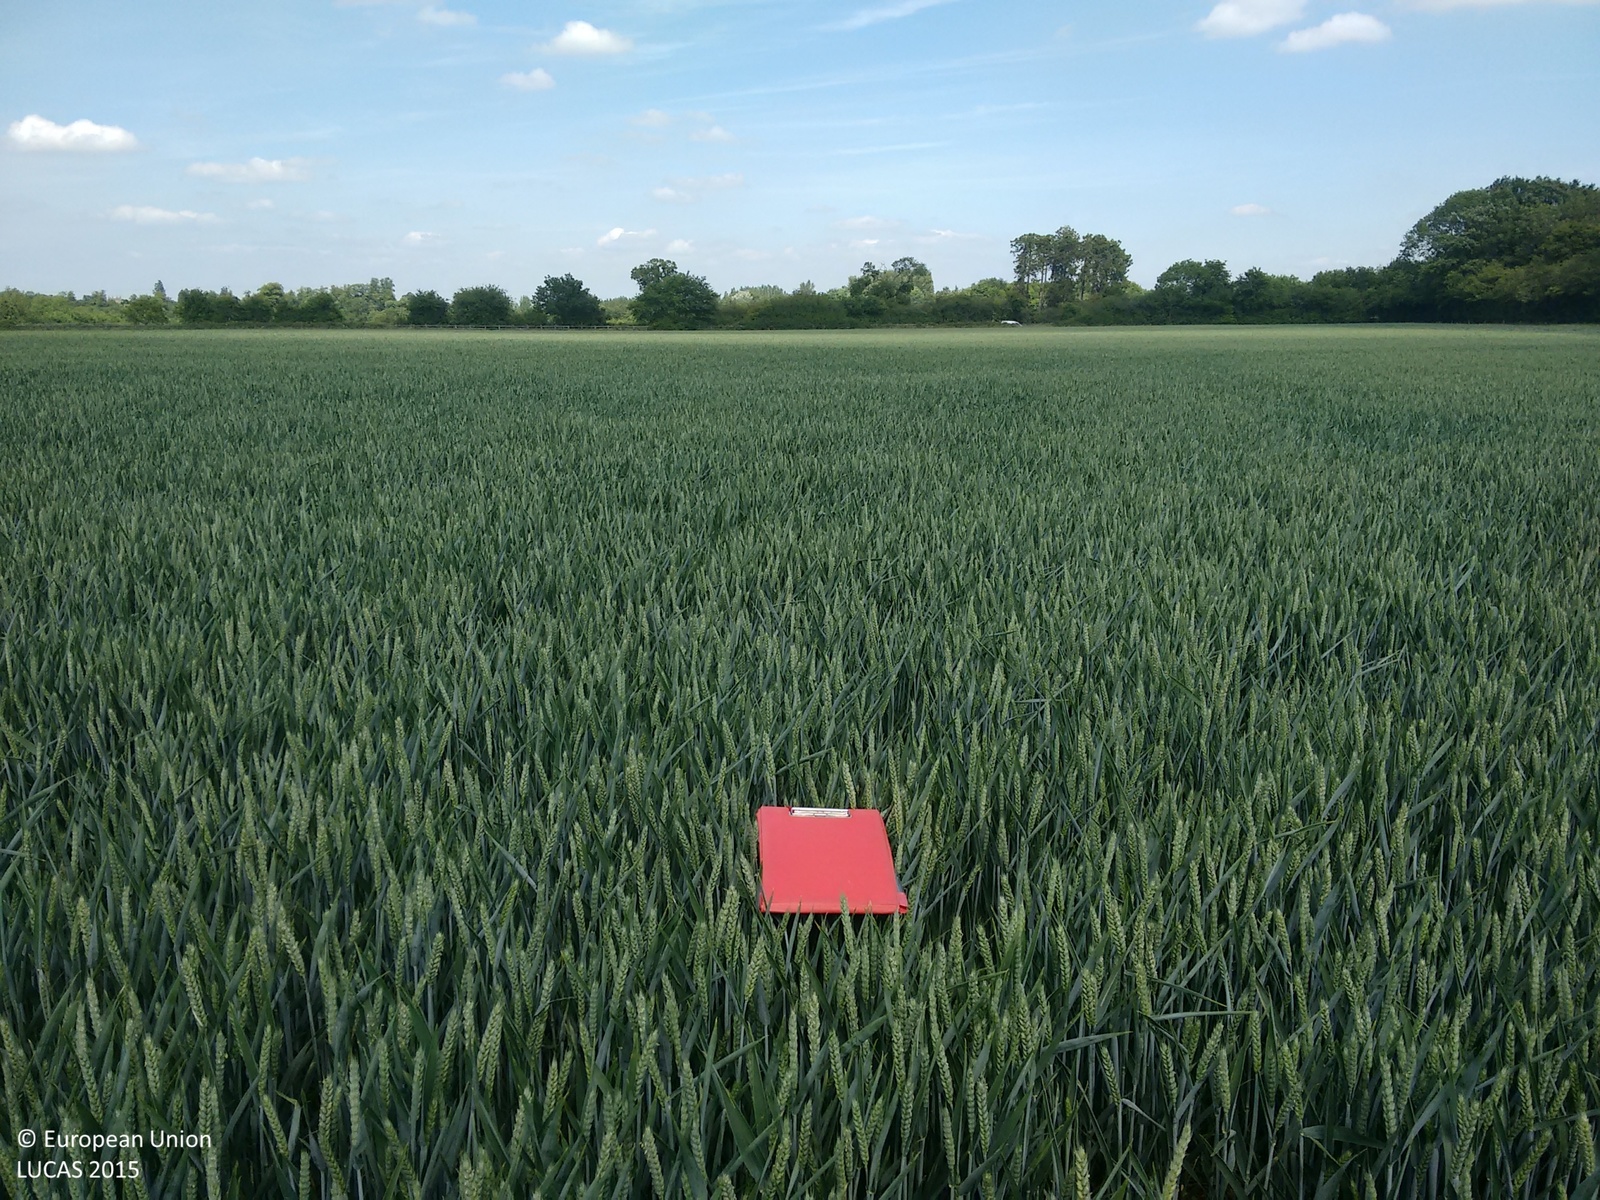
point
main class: Cropland
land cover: Common wheat
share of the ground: > 75 %
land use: Agriculture (excluding fallow land and kitchen gardens)
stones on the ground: < 10 %
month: June
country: GB
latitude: 51.5080
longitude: -2.2077
